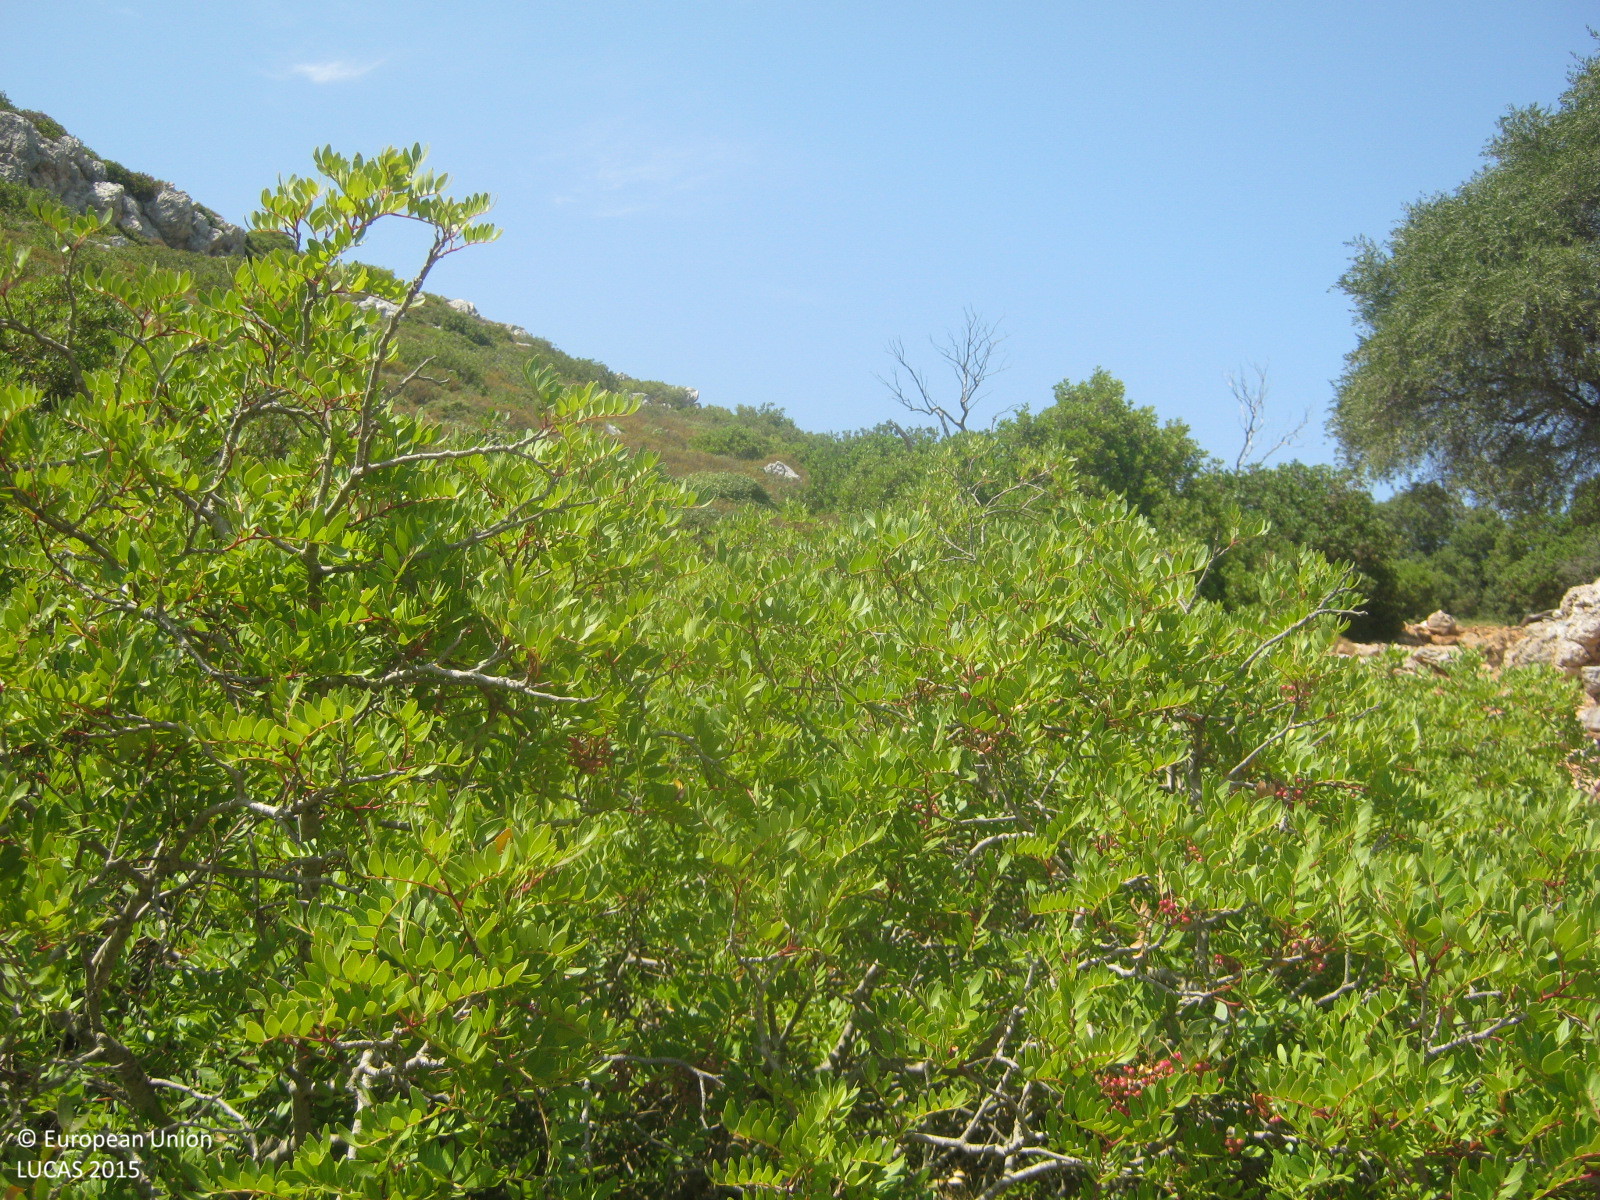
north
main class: Shrubland
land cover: Shrubland without tree cover
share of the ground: > 75 %
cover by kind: shrubs 90 %, consolidated bare surface 10 %
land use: Semi-natural and natural areas not in use
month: August
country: GR
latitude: 38.3055
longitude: 20.4255
